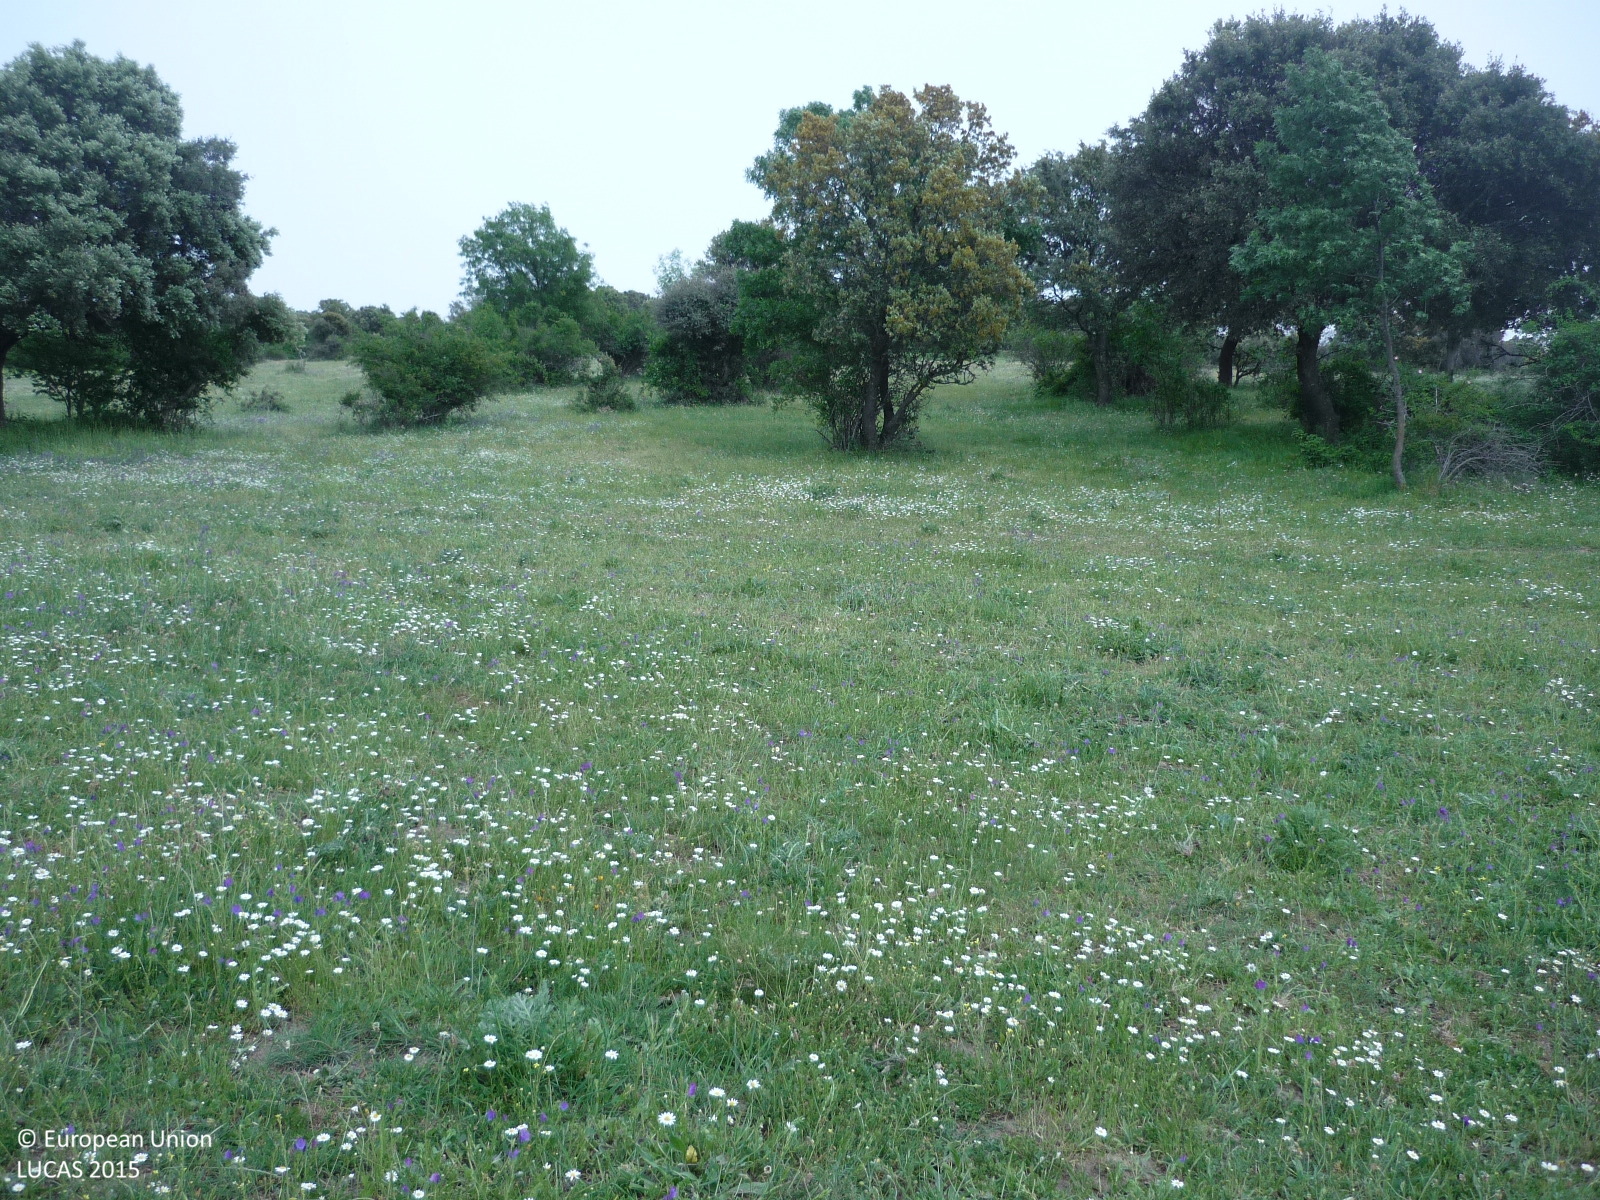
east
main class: Grassland
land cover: Grassland with sparse tree/shrub cover
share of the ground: > 75 %
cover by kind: herbaceous plants 85 %, shrubs 10 %, broadleaved forest trees 5 %
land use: Agriculture (excluding fallow land and kitchen gardens)
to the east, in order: Grassland with sparse tree/shrub cover; Tracks; Shrubland with sparse tree cover; Grassland with sparse tree/shrub cover; Broadleaved woodland; Grassland without tree/shrub cover; Dry stone walls; Groves; Grassland without tree/shrub cover; Single bushes/trees; Grassland without tree/shrub cover
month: May
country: ES
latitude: 40.7013
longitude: -3.9030
